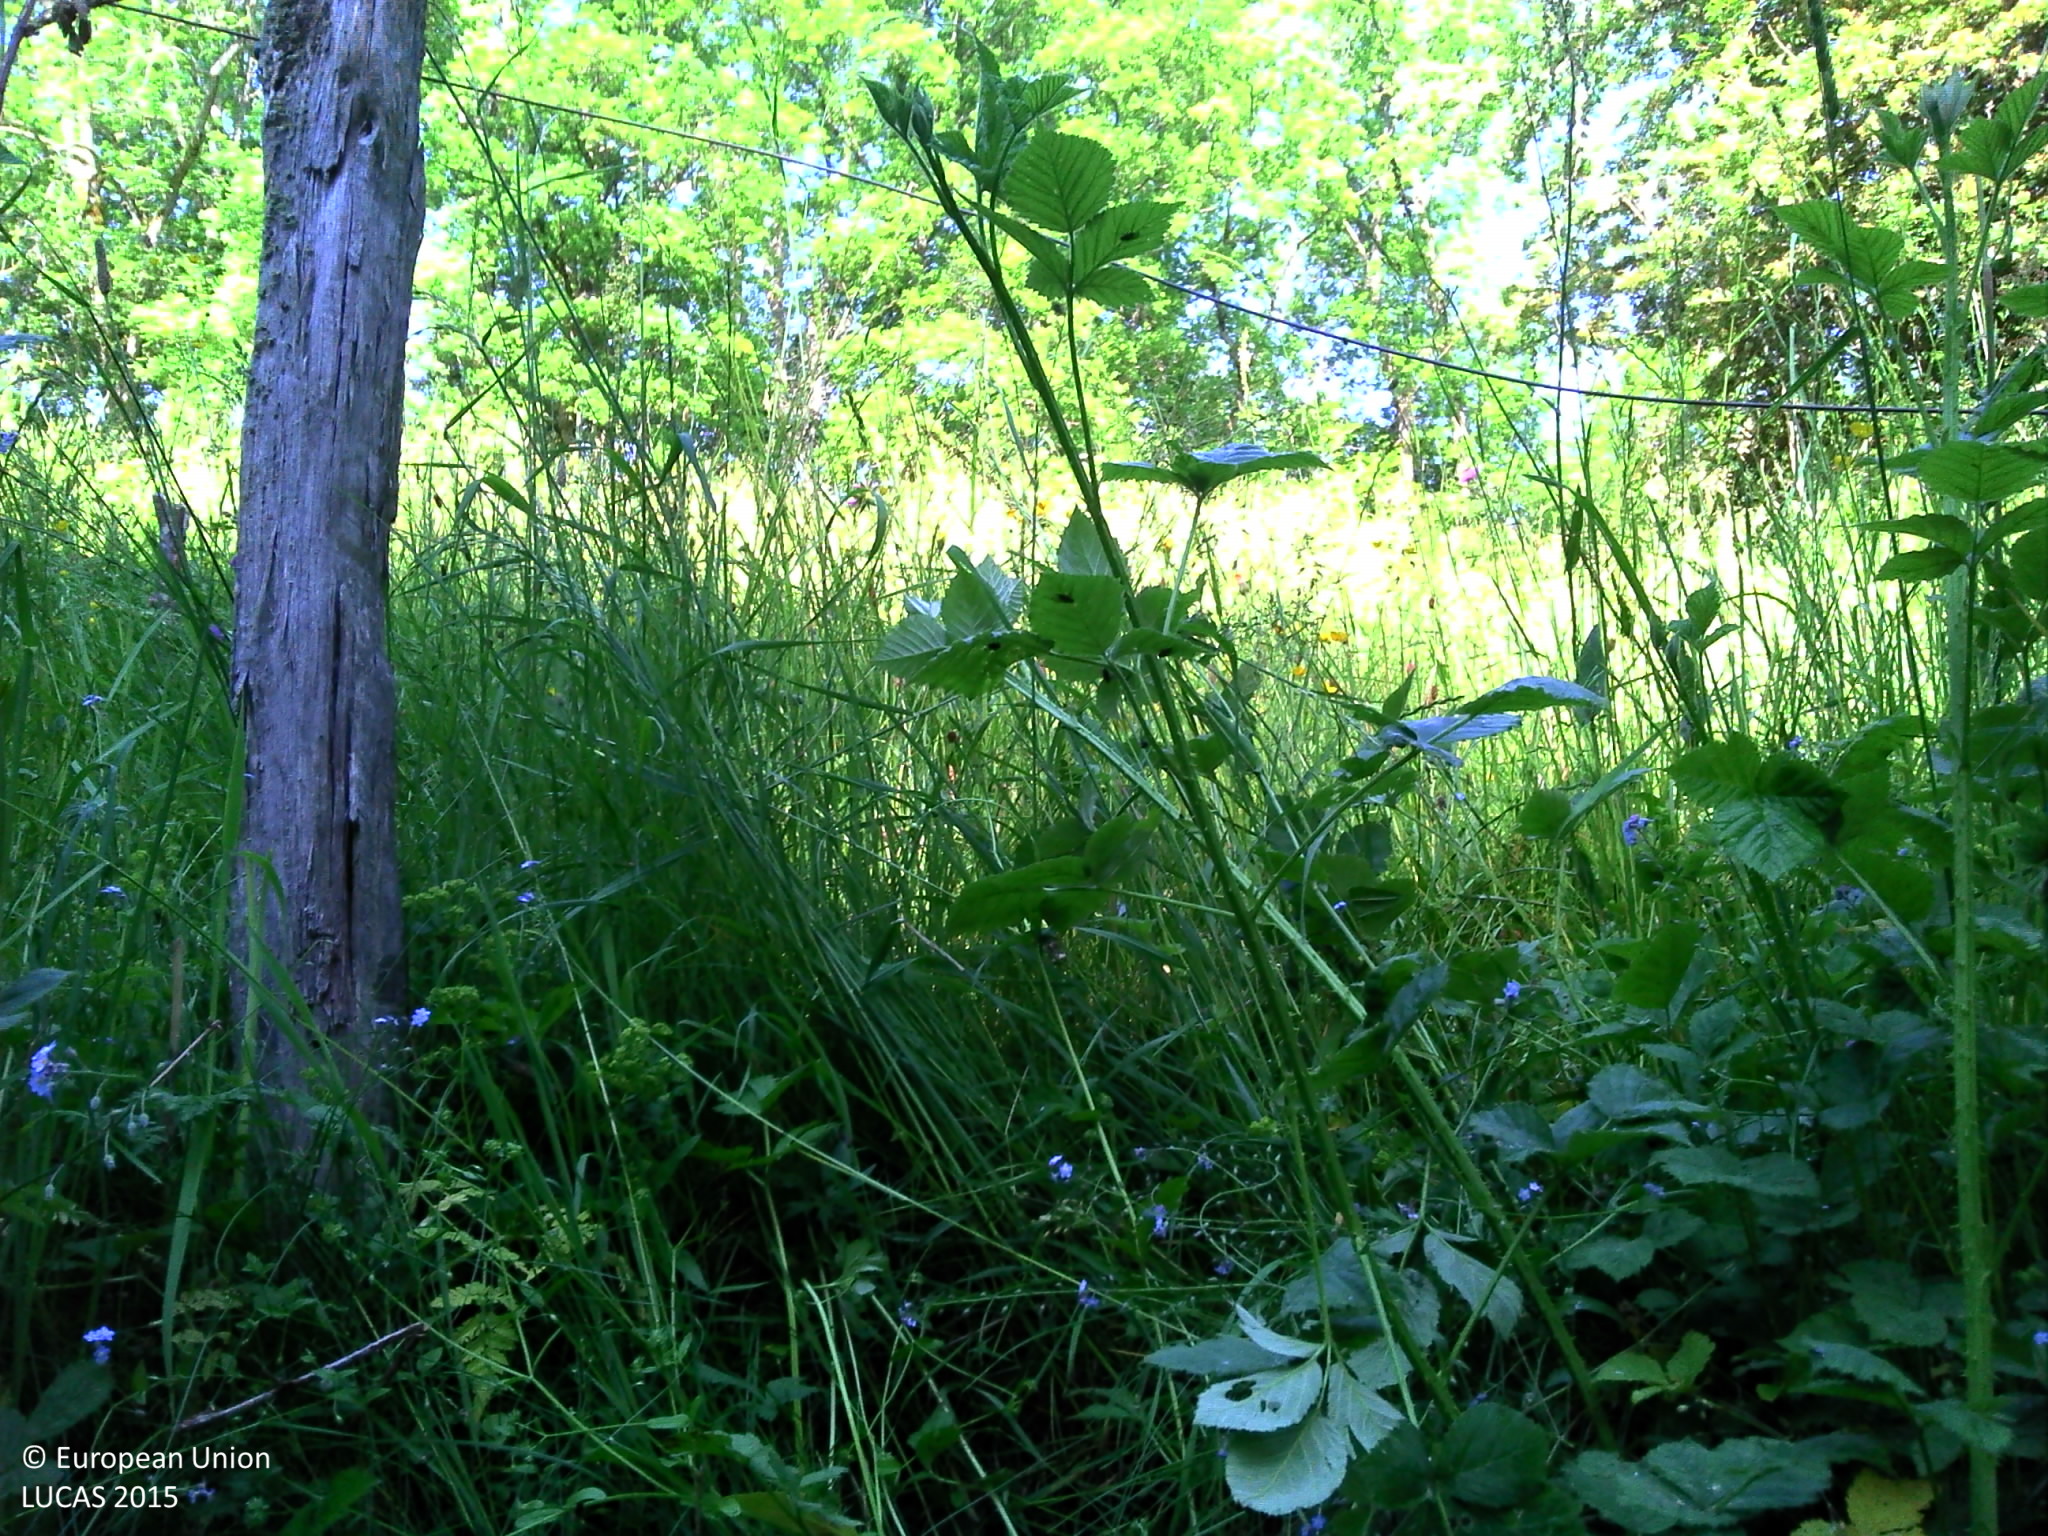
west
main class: Grassland
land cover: Grassland without tree/shrub cover
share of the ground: > 75 %
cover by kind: herbaceous plants 100 %
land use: Agriculture (excluding fallow land and kitchen gardens)
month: June
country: FR
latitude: 44.9314
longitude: 3.0463
